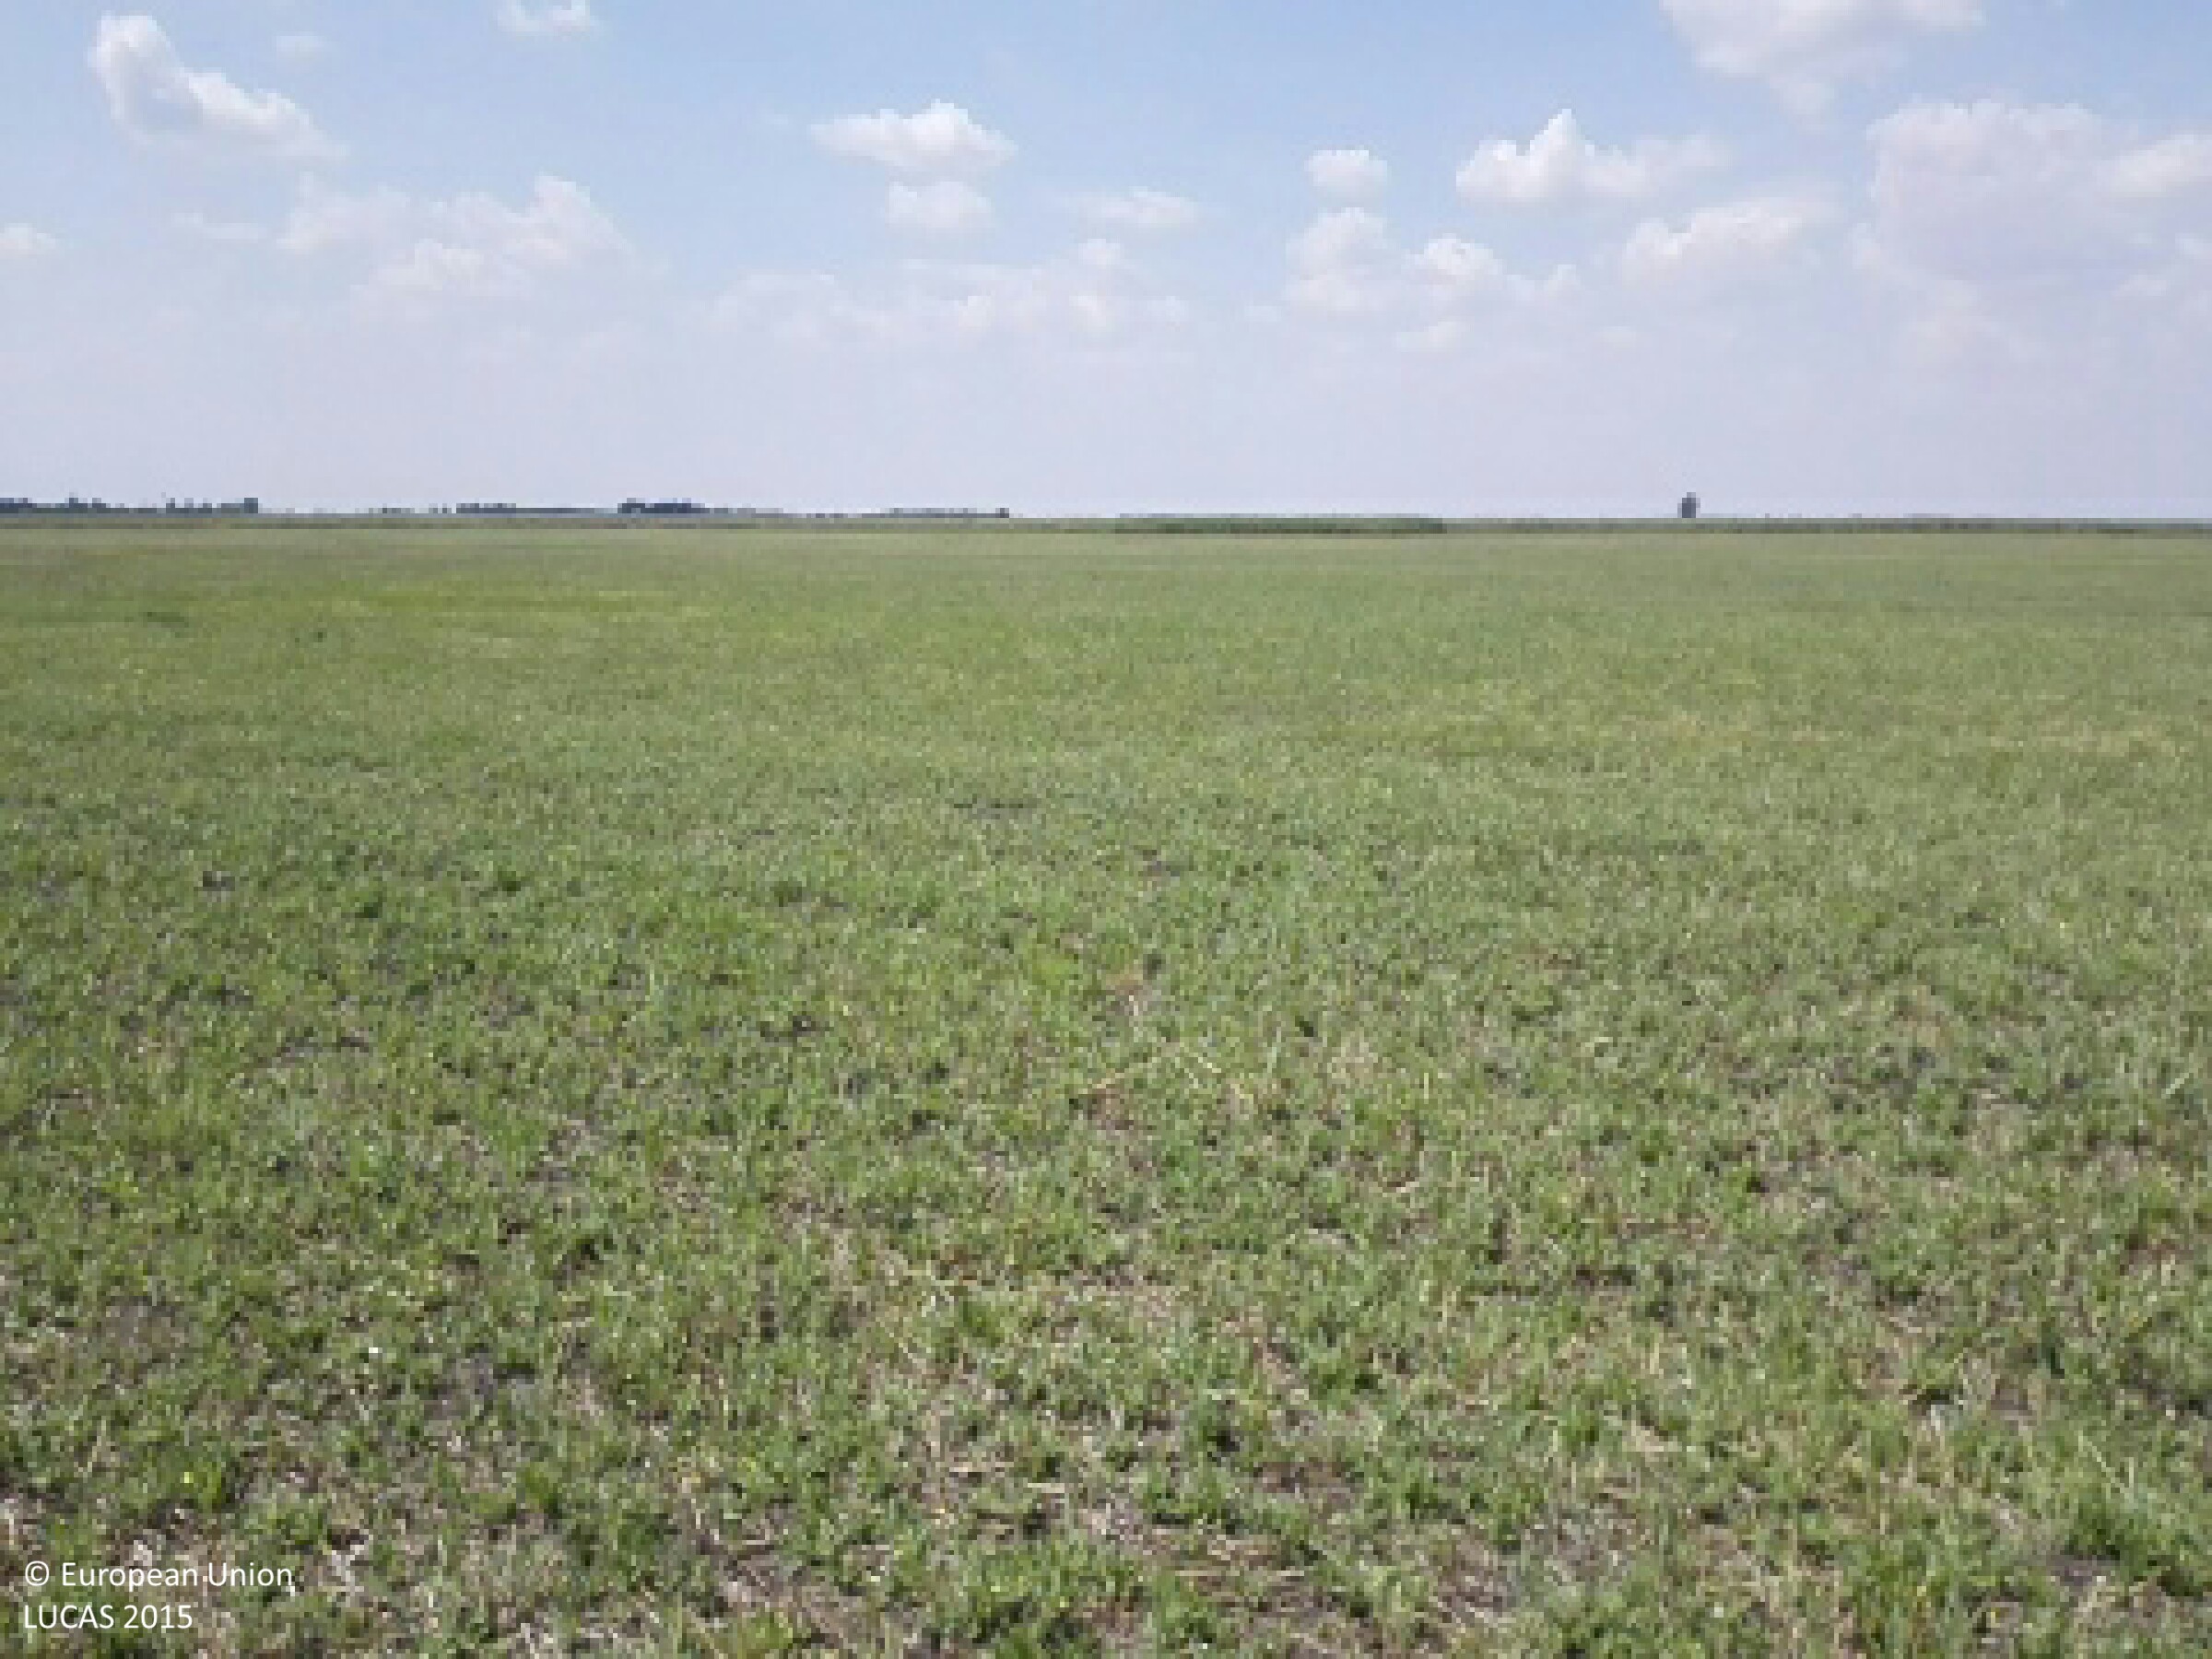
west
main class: Cropland
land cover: Other fibre and oleaginous crops
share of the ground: 50 - 75 %
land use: Agriculture (excluding fallow land and kitchen gardens)
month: July
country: HU
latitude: 47.2960
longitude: 21.2930
